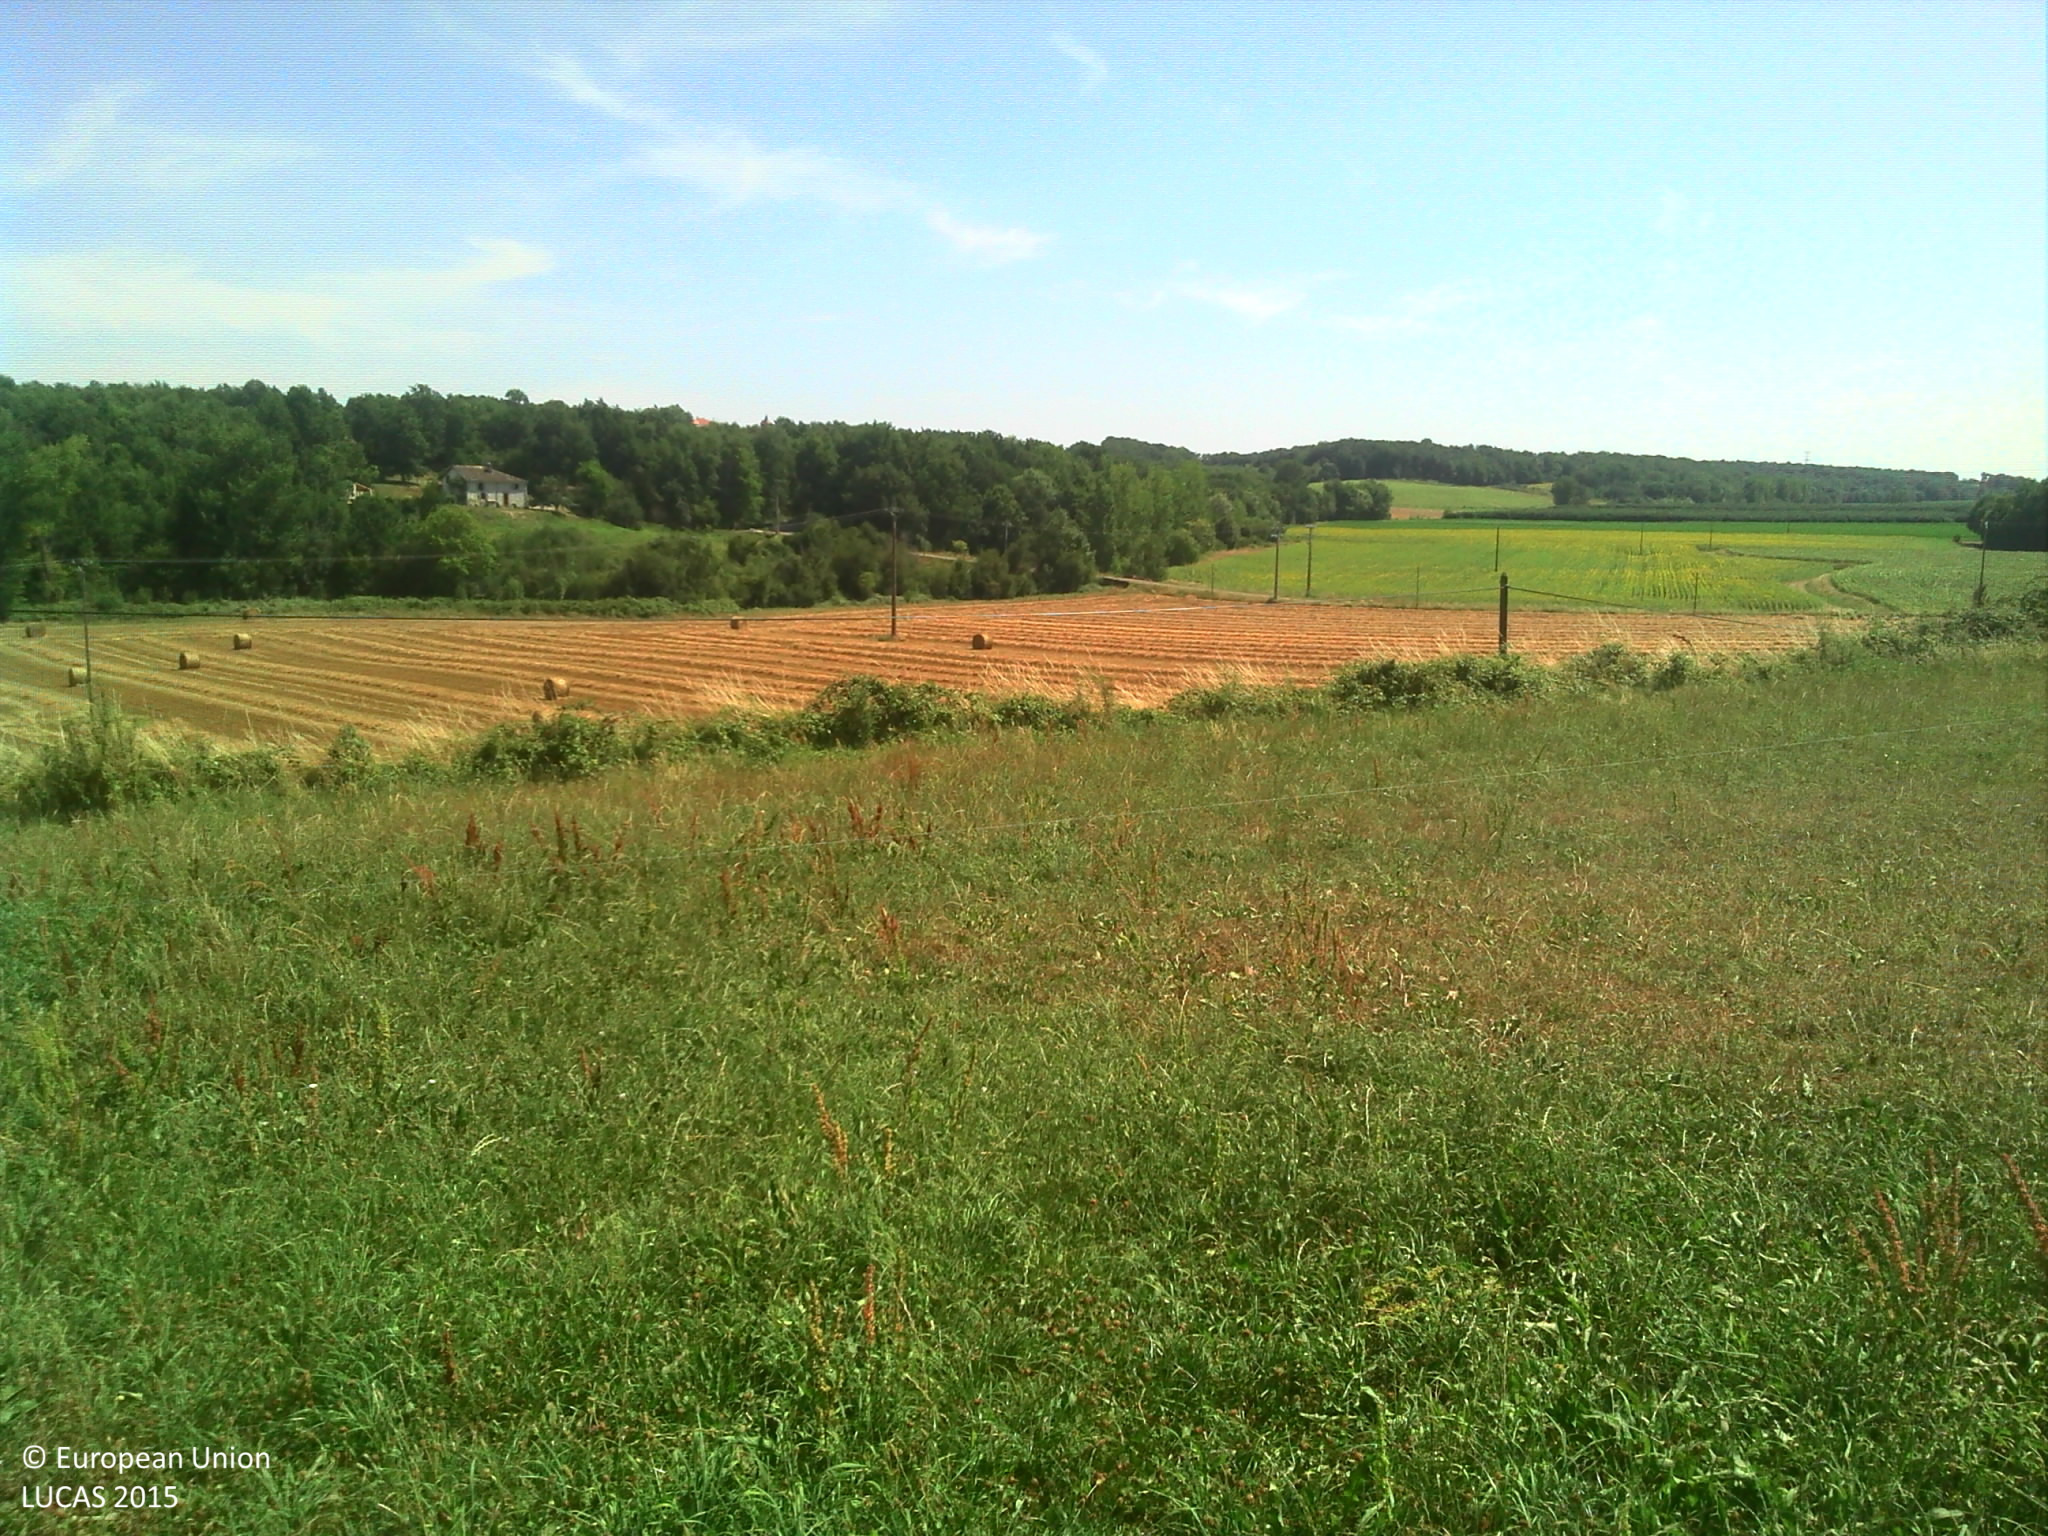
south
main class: Grassland
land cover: Grassland without tree/shrub cover
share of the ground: > 75 %
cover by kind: herbaceous plants 100 %
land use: Agriculture (excluding fallow land and kitchen gardens)
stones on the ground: 10 - 25 %
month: July
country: FR
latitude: 44.0115
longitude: 0.9798
